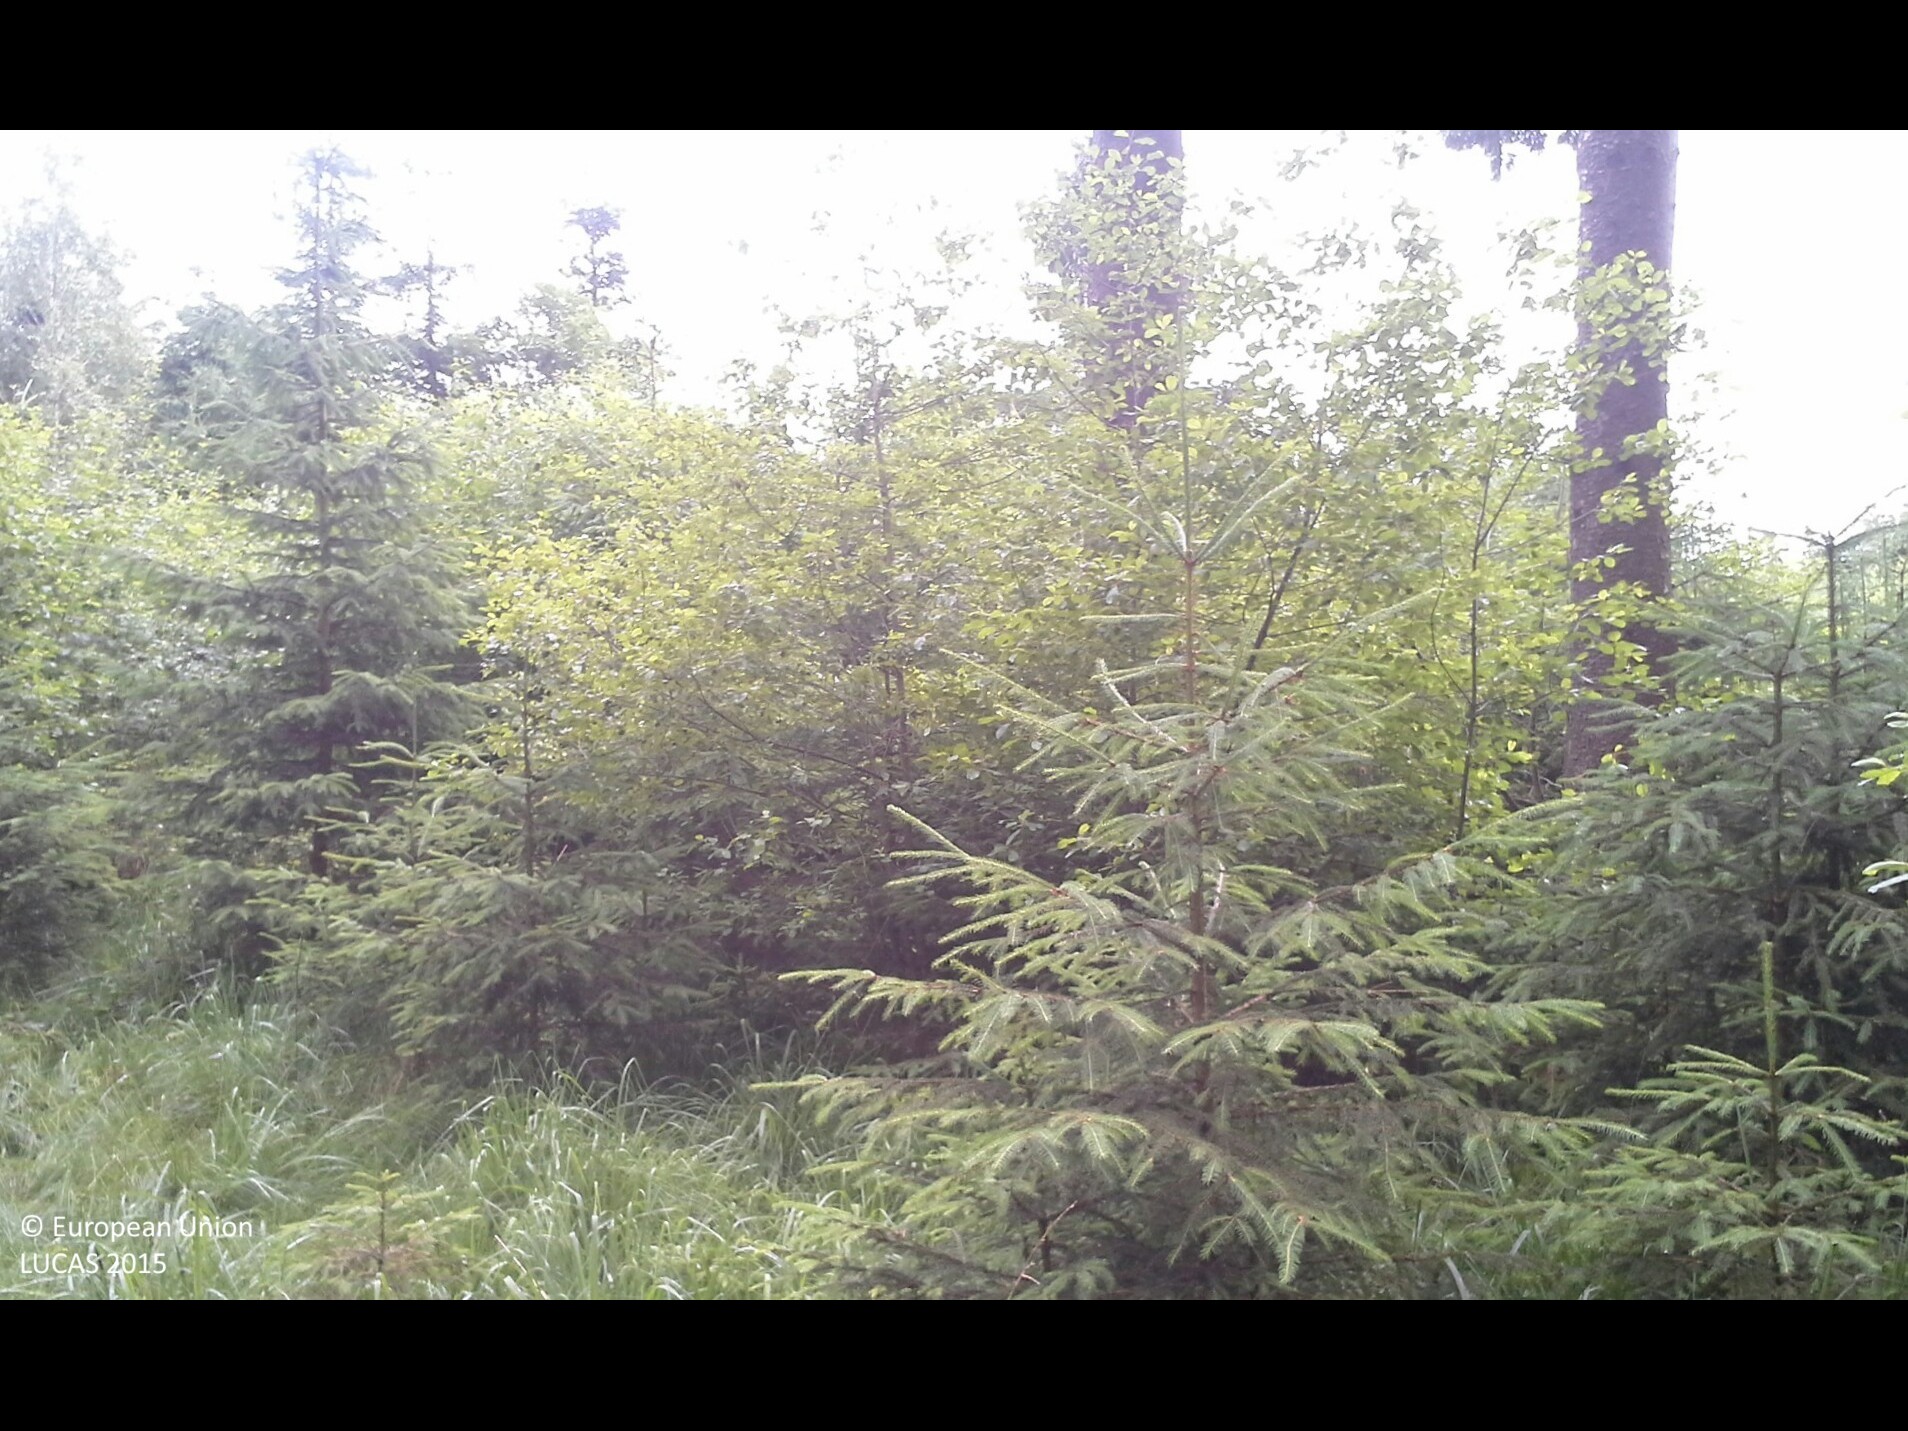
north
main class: Woodland
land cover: Spruce dominated mixed woodland
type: hemiboreal forest and nemoral coniferous forest and mixed broadleaved-coniferous forest
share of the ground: > 75 %
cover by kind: coniferous forest trees 60 %, broadleaved forest trees 25 %, herbaceous plants 10 %, shrubs 5 %
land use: Forestry
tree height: > 5 m
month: June
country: AT
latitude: 48.0924
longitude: 14.5787
